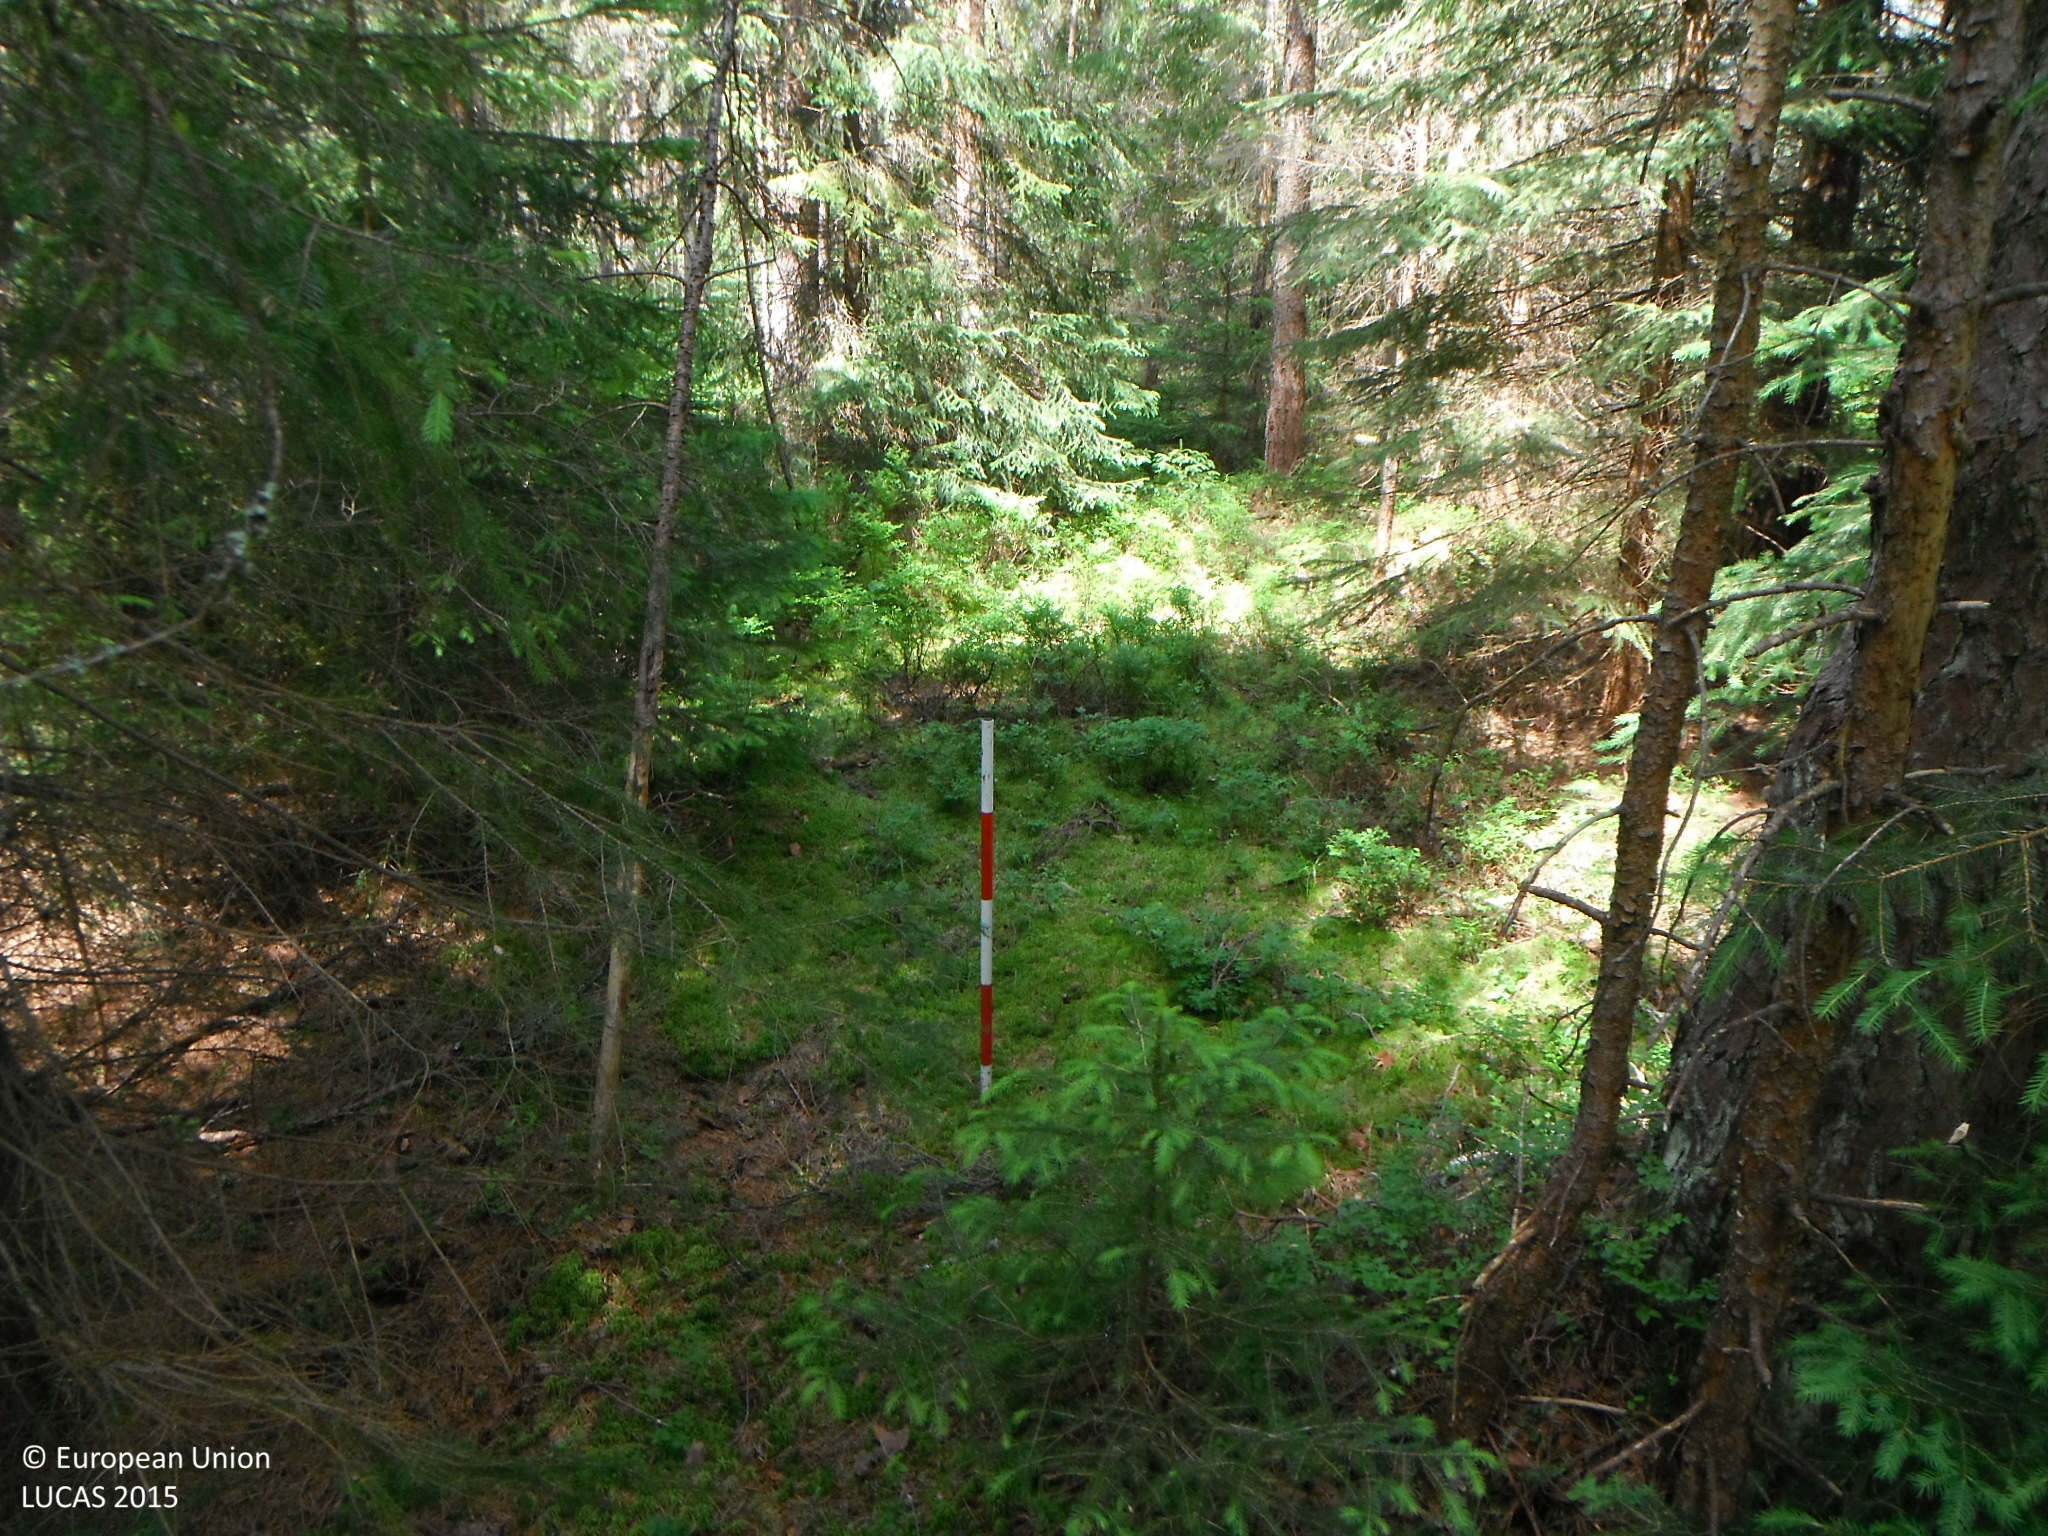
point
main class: Woodland
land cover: Spruce dominated coniferous woodland
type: alpine coniferous forest
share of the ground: > 75 %
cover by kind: coniferous forest trees 100 %
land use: Forestry
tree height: > 5 m
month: July
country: SK
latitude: 49.4012
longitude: 19.7717
